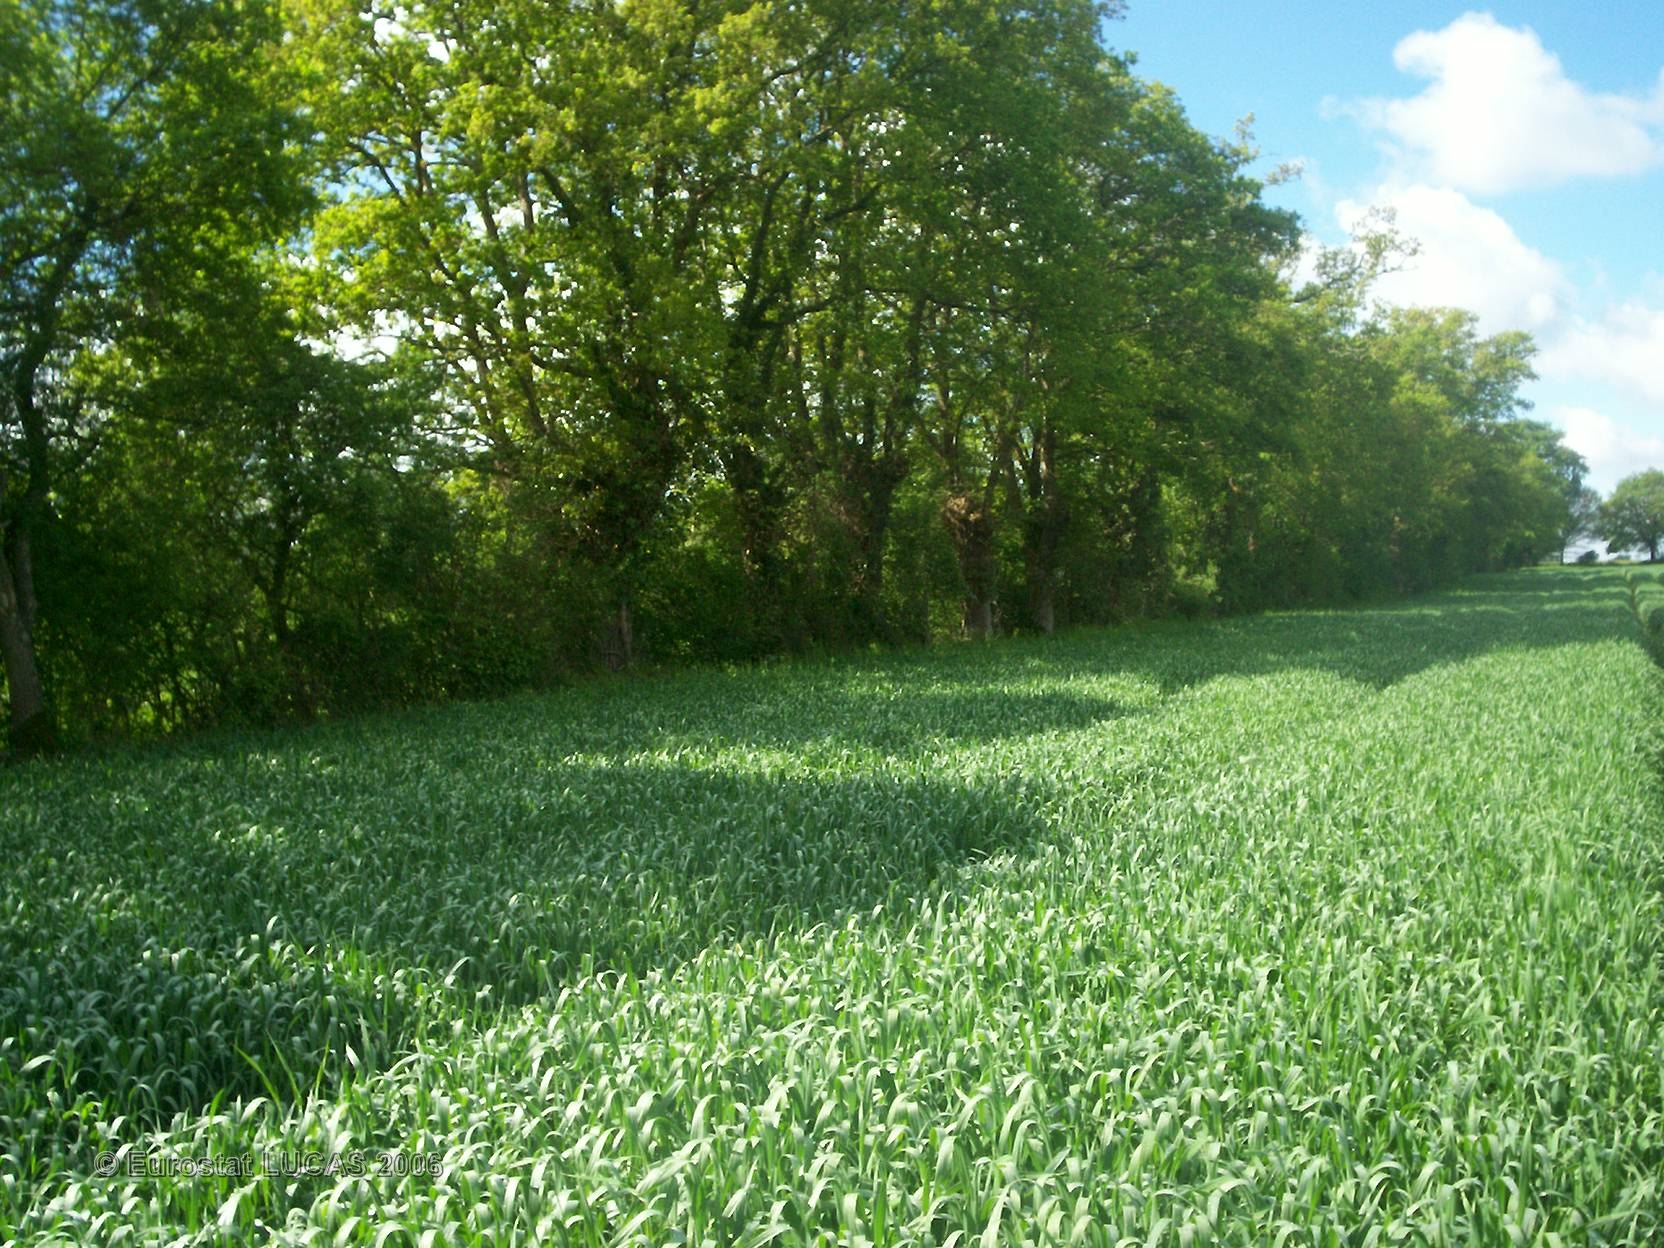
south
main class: Cropland
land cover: Common wheat
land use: Agriculture (excluding fallow land and kitchen gardens)
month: May
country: FR
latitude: 48.0538
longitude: -0.6203
